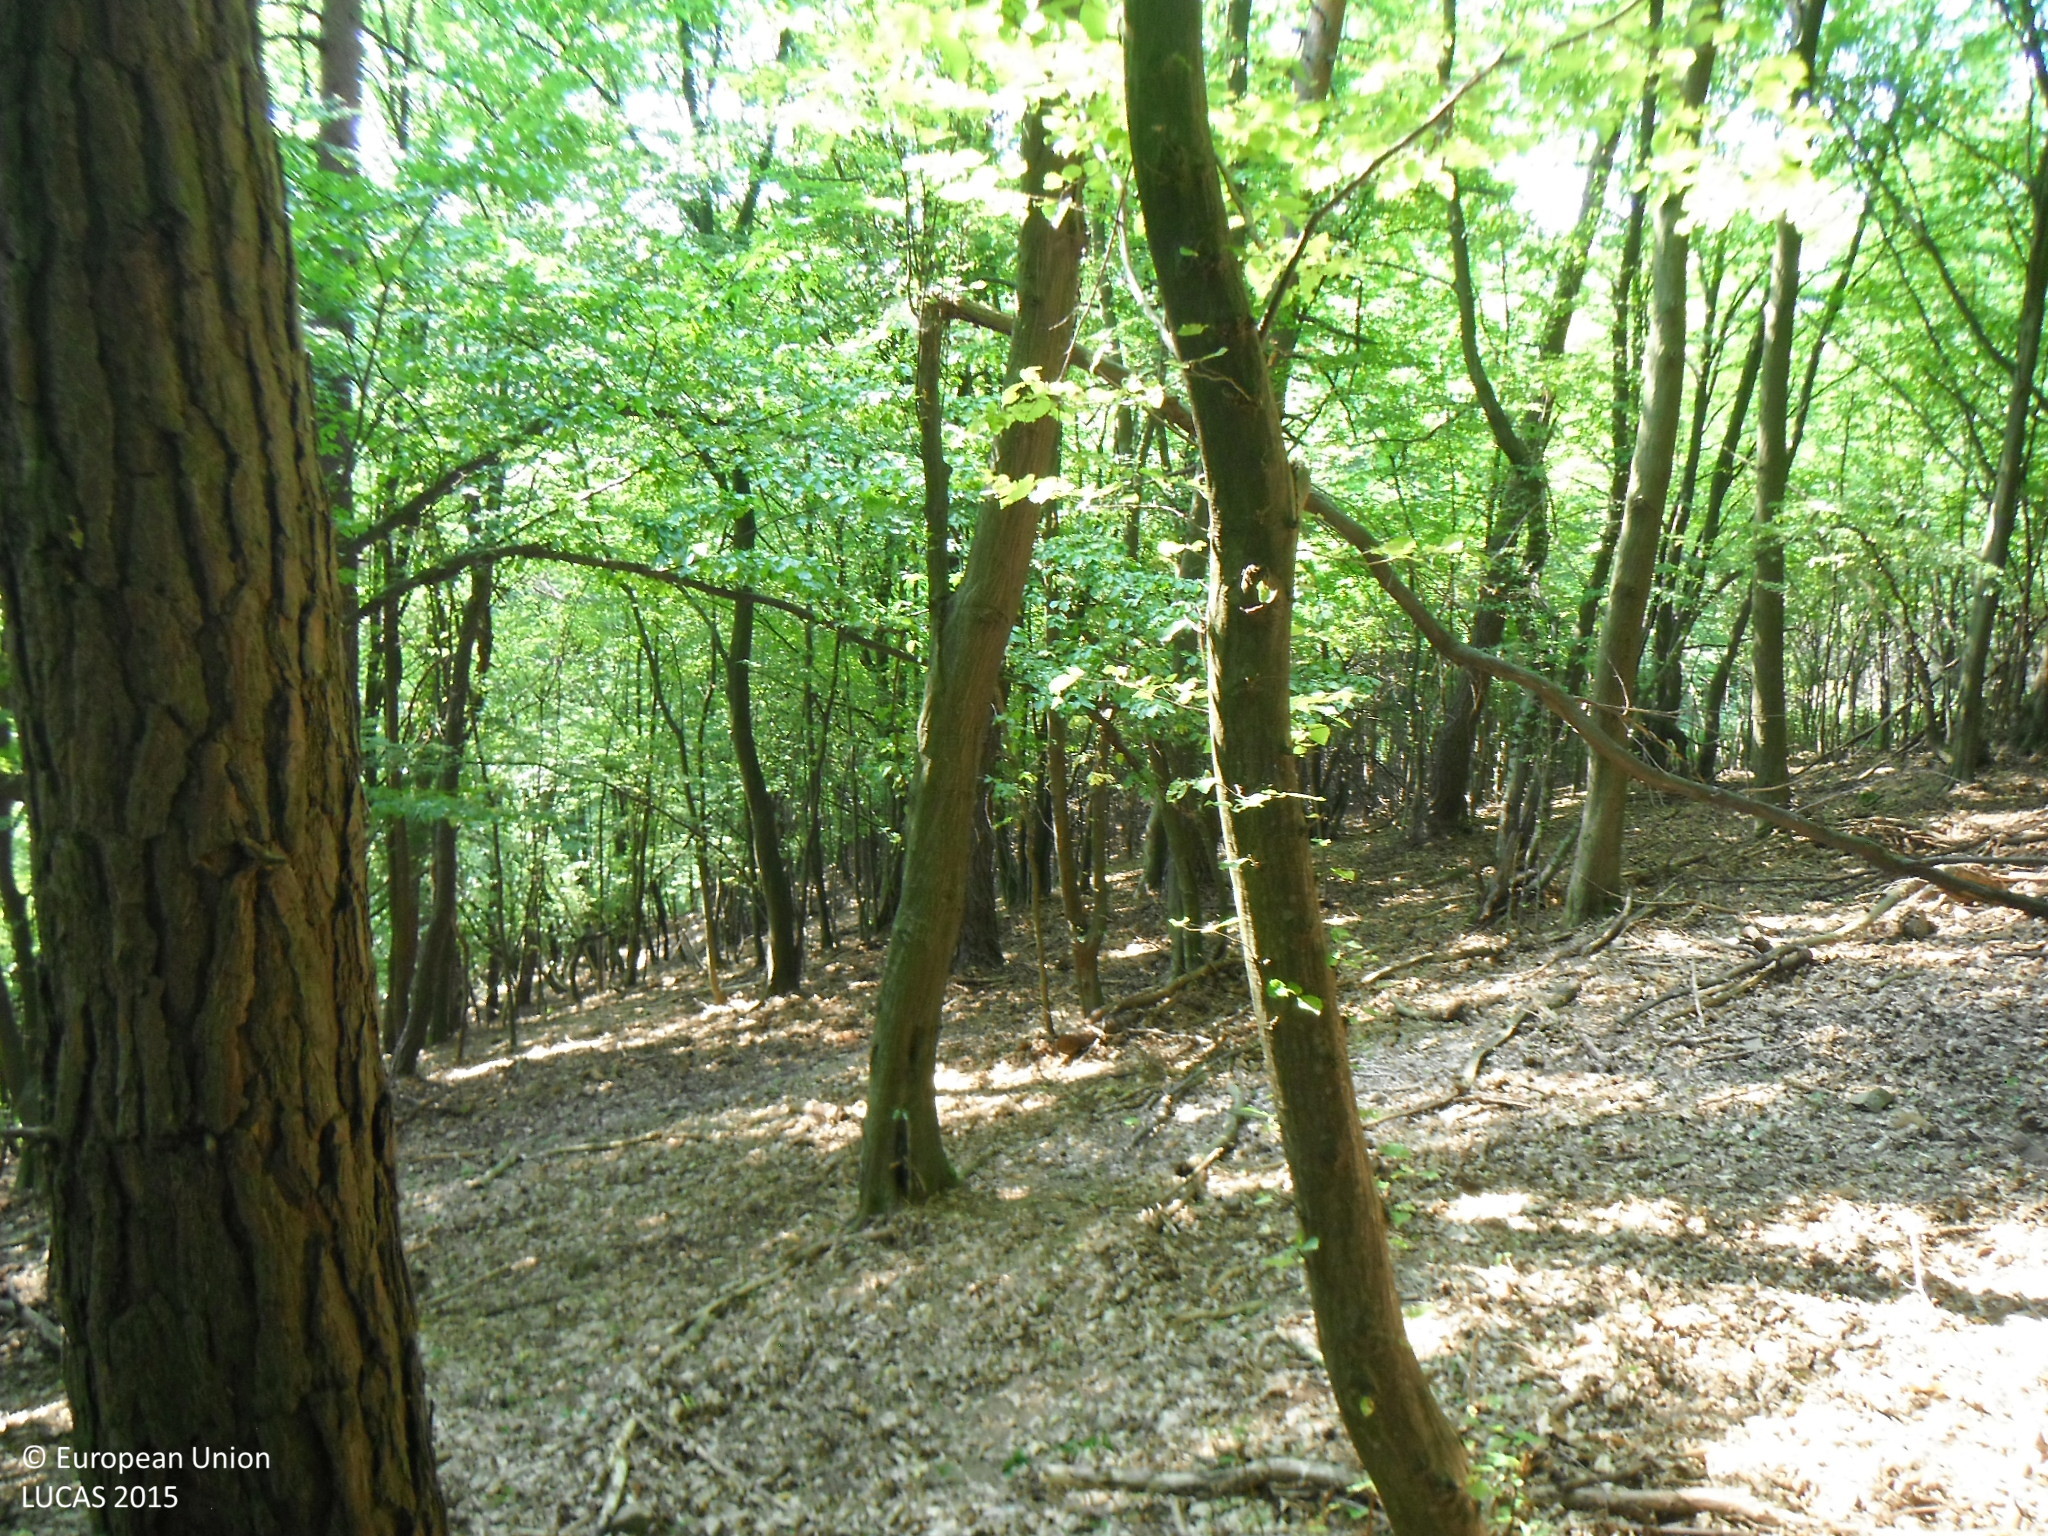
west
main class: Woodland
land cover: Pine dominated mixed woodland
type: mesophytic deciduous forest
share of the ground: > 75 %
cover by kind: broadleaved forest trees 60 %, coniferous forest trees 40 %
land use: Forestry
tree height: > 5 m
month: August
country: SK
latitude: 49.1770
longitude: 18.2883
